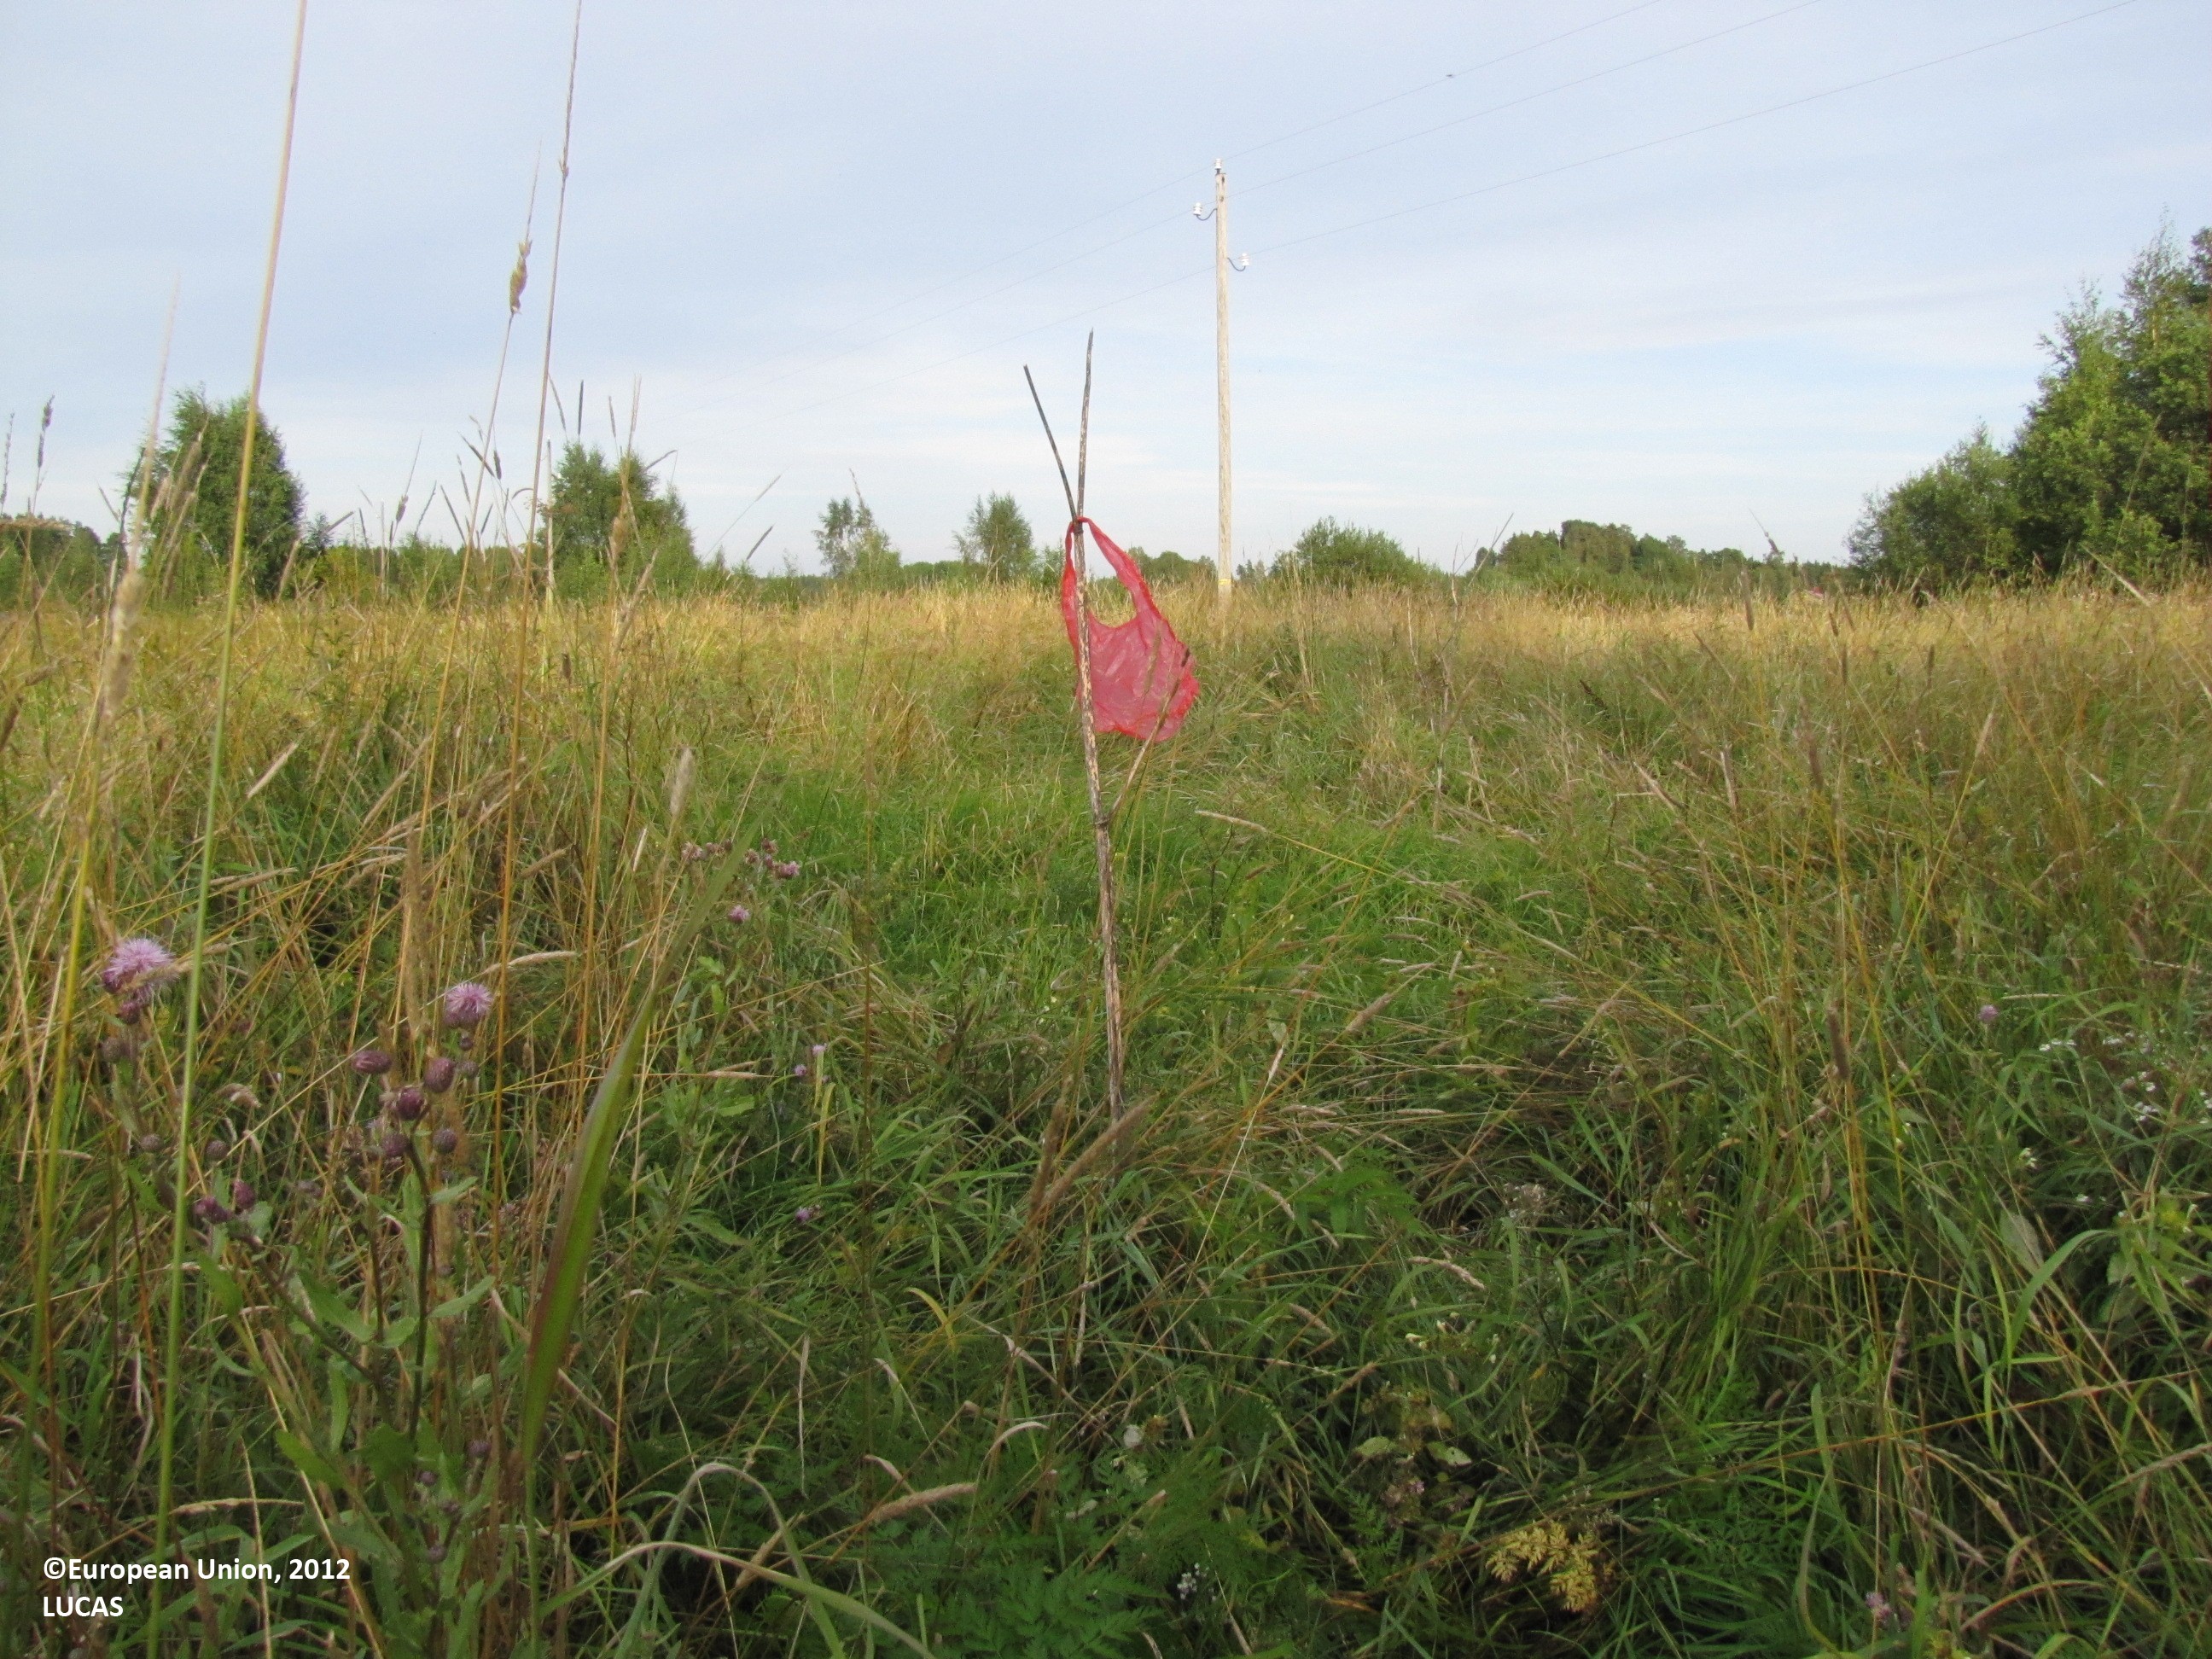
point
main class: Grassland
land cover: Grassland without tree/shrub cover
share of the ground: > 75 %
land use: Fallow land
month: August
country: FI
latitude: 61.3883
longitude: 23.5785
